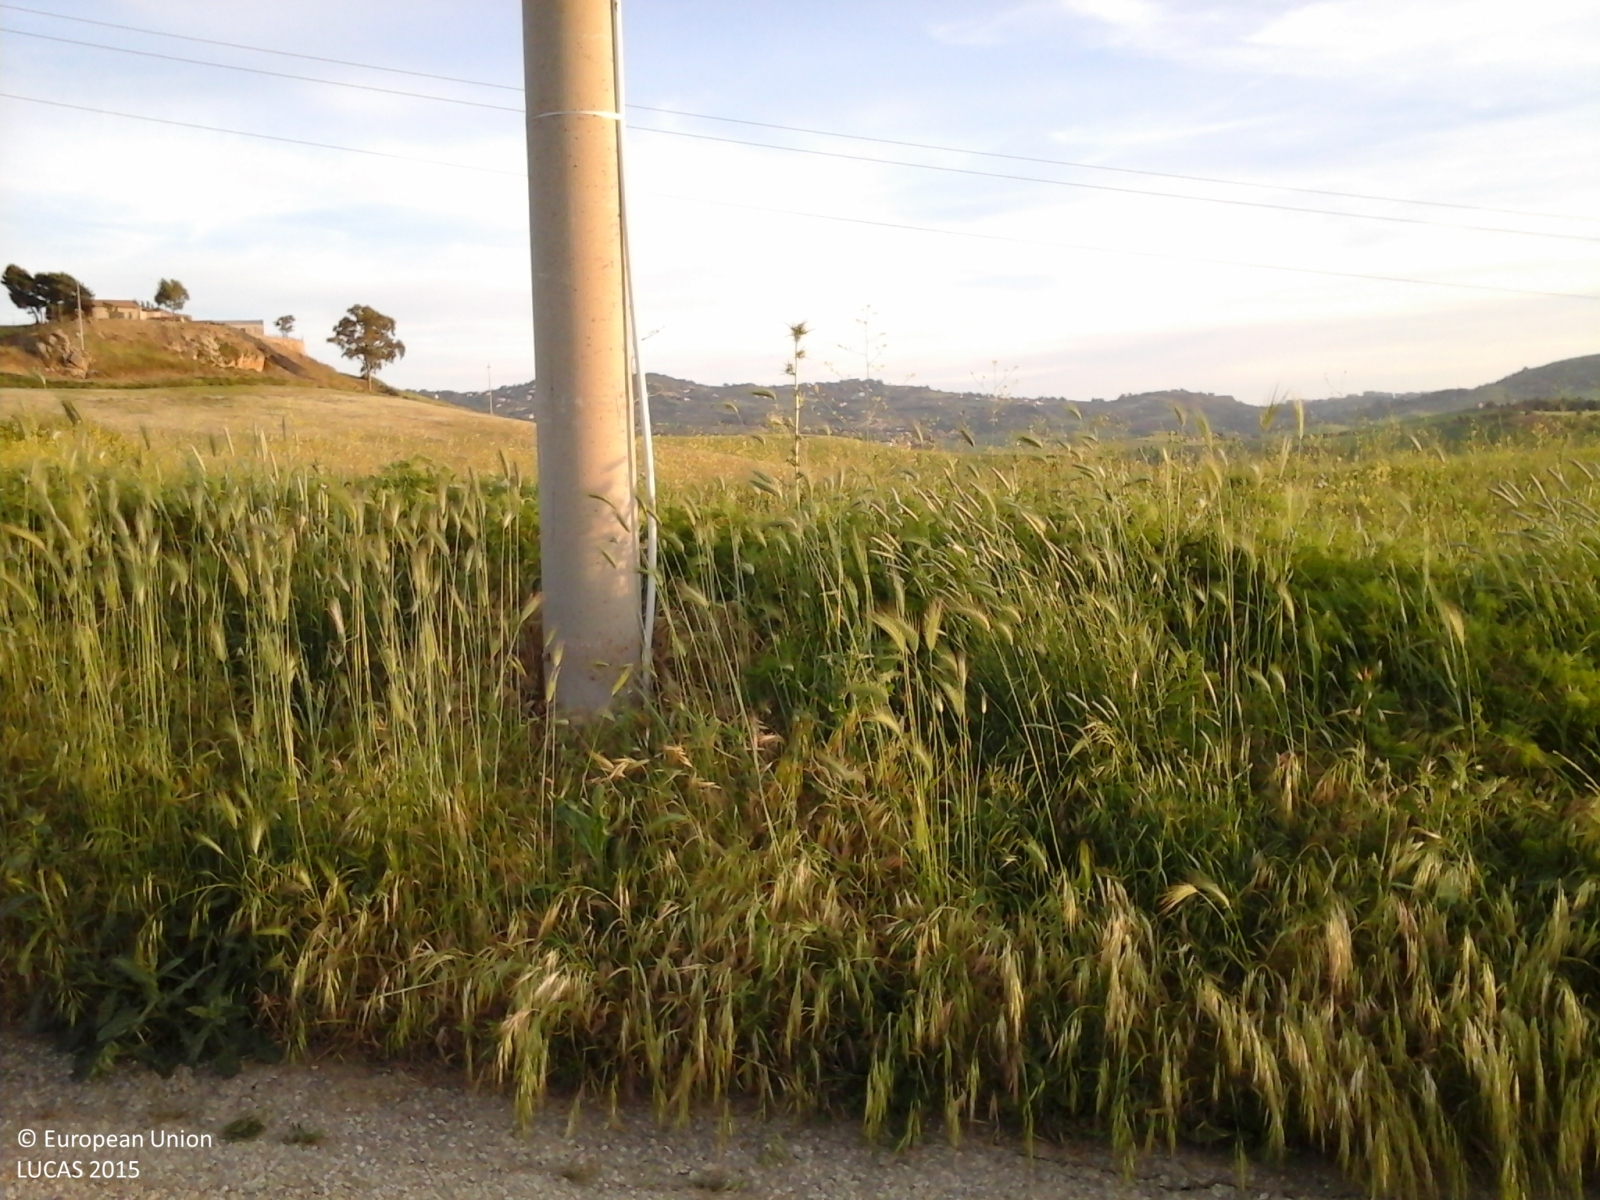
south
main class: Cropland
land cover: Other leguminous and mixtures for fodder
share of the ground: > 75 %
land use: Agriculture (excluding fallow land and kitchen gardens)
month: May
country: IT
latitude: 37.5348
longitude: 14.0327
